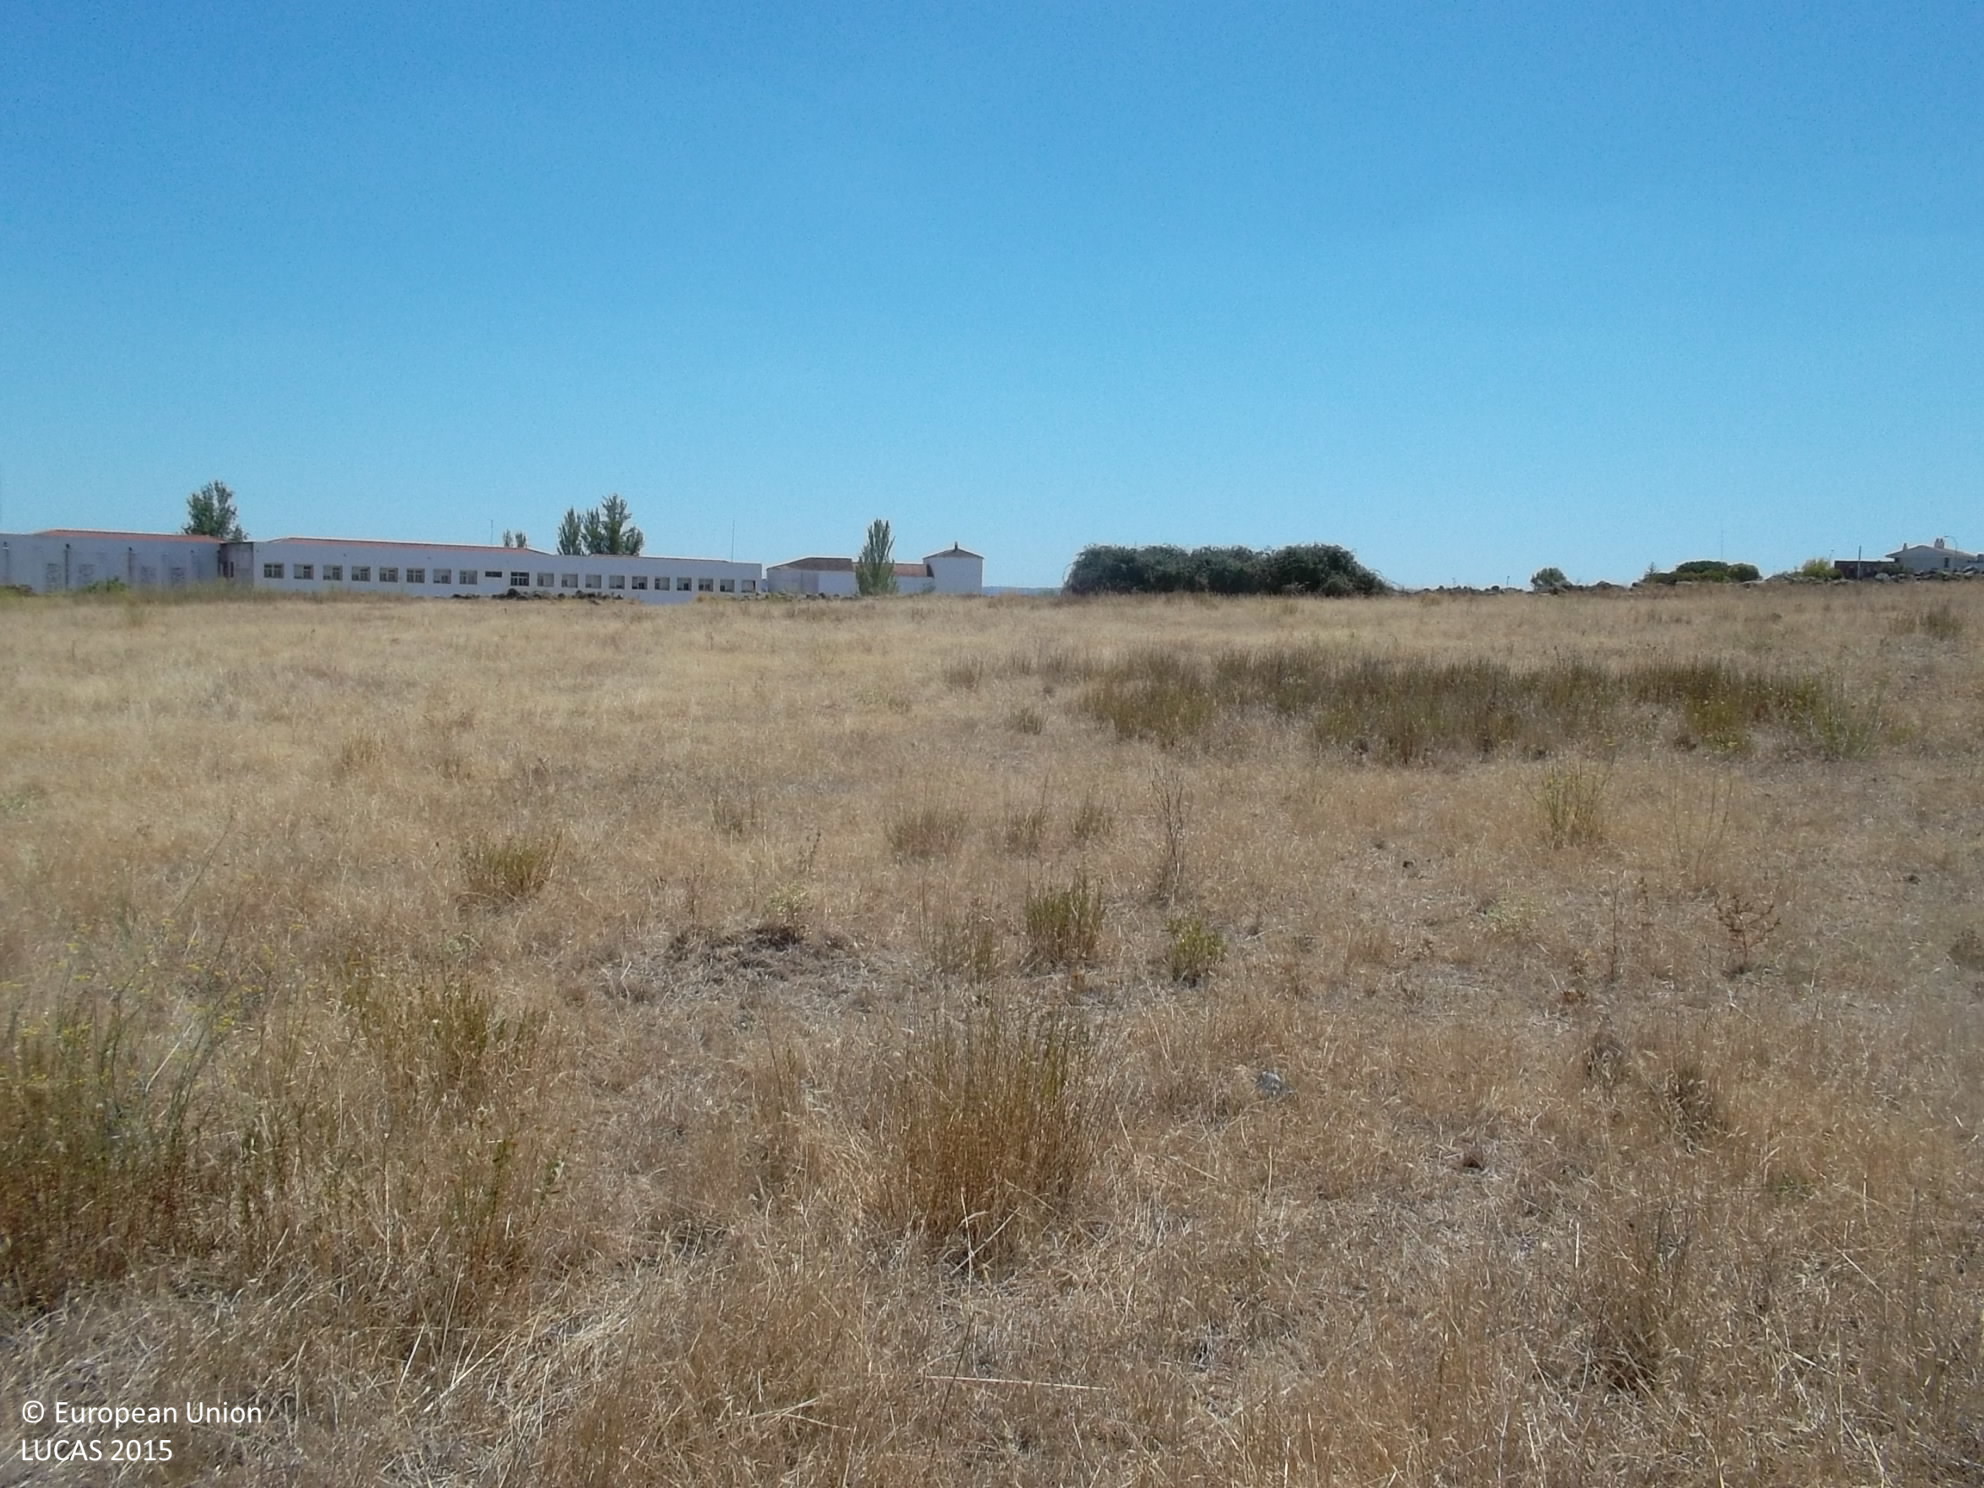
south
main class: Grassland
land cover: Spontaneously vegetated surfaces
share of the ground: > 75 %
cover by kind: herbaceous plants 100 %
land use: Fallow land
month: August
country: ES
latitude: 38.1681
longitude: -6.6579
